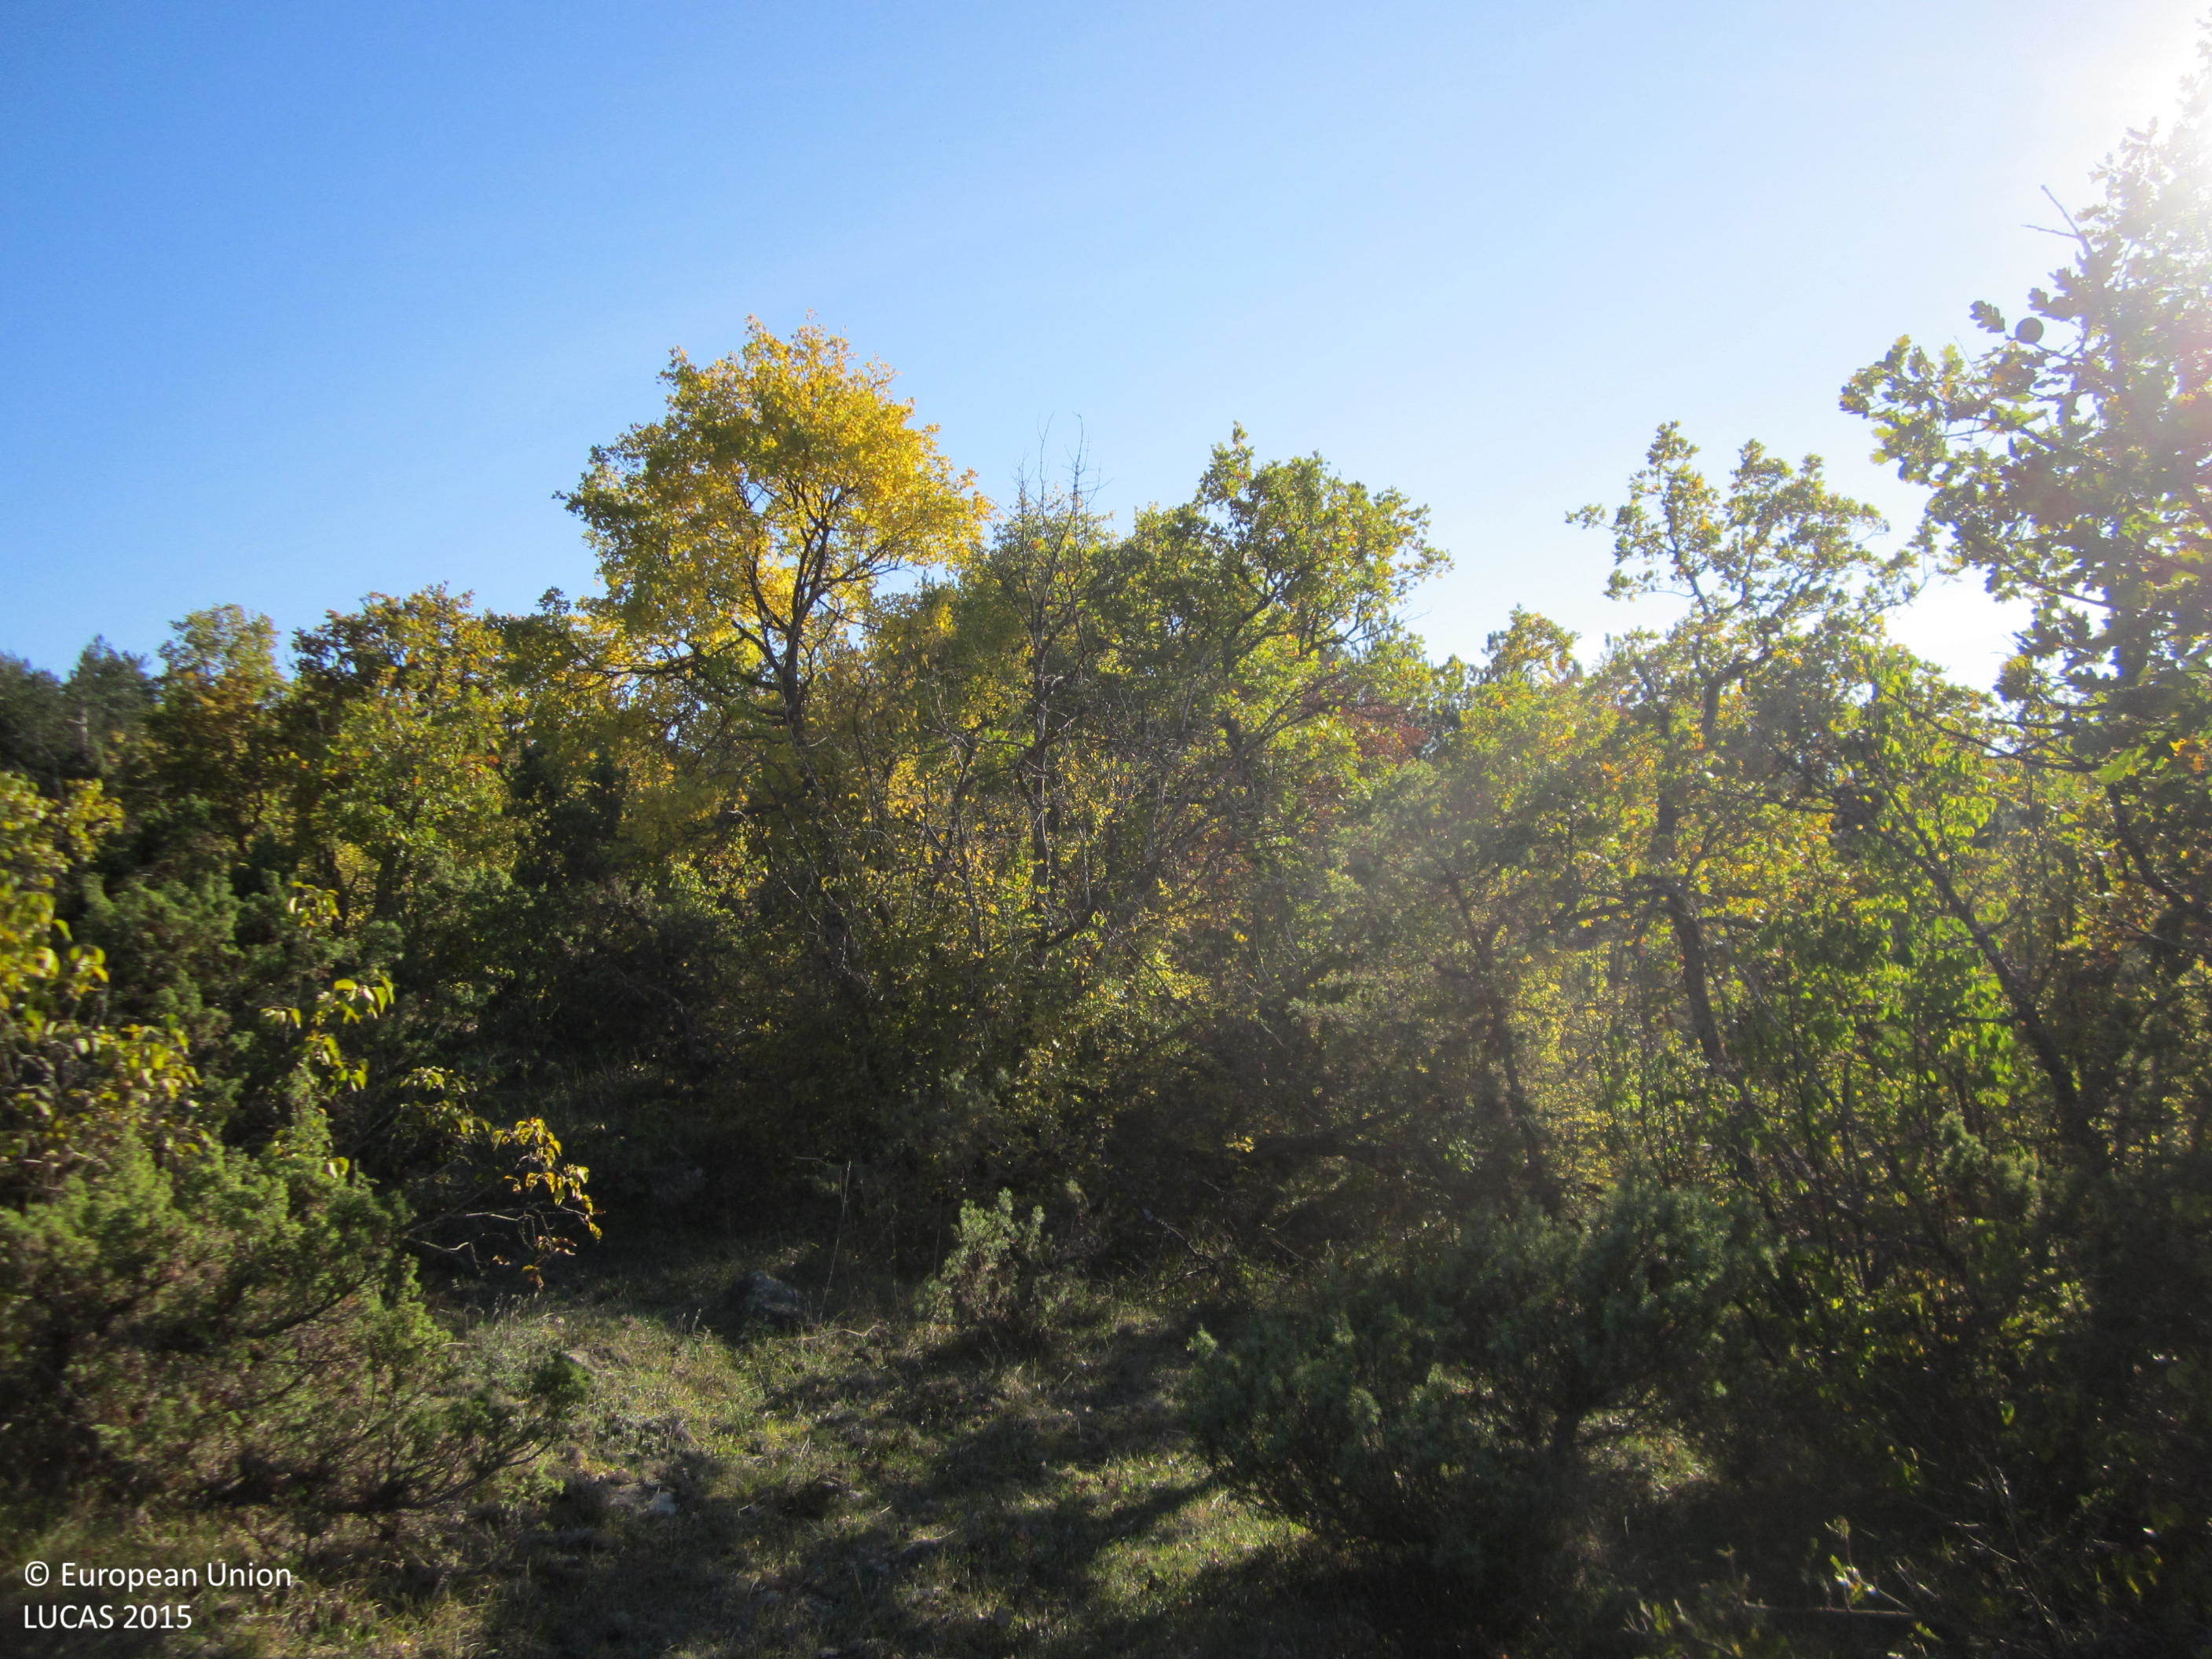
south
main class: Shrubland
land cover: Shrubland with sparse tree cover
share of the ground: 50 - 75 %
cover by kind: shrubs 55 %, herbaceous plants 35 %, broadleaved forest trees 5 %, unconsolidated bare surface 5 %
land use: Agriculture (excluding fallow land and kitchen gardens)
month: November
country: BG
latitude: 41.6011
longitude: 25.7209
